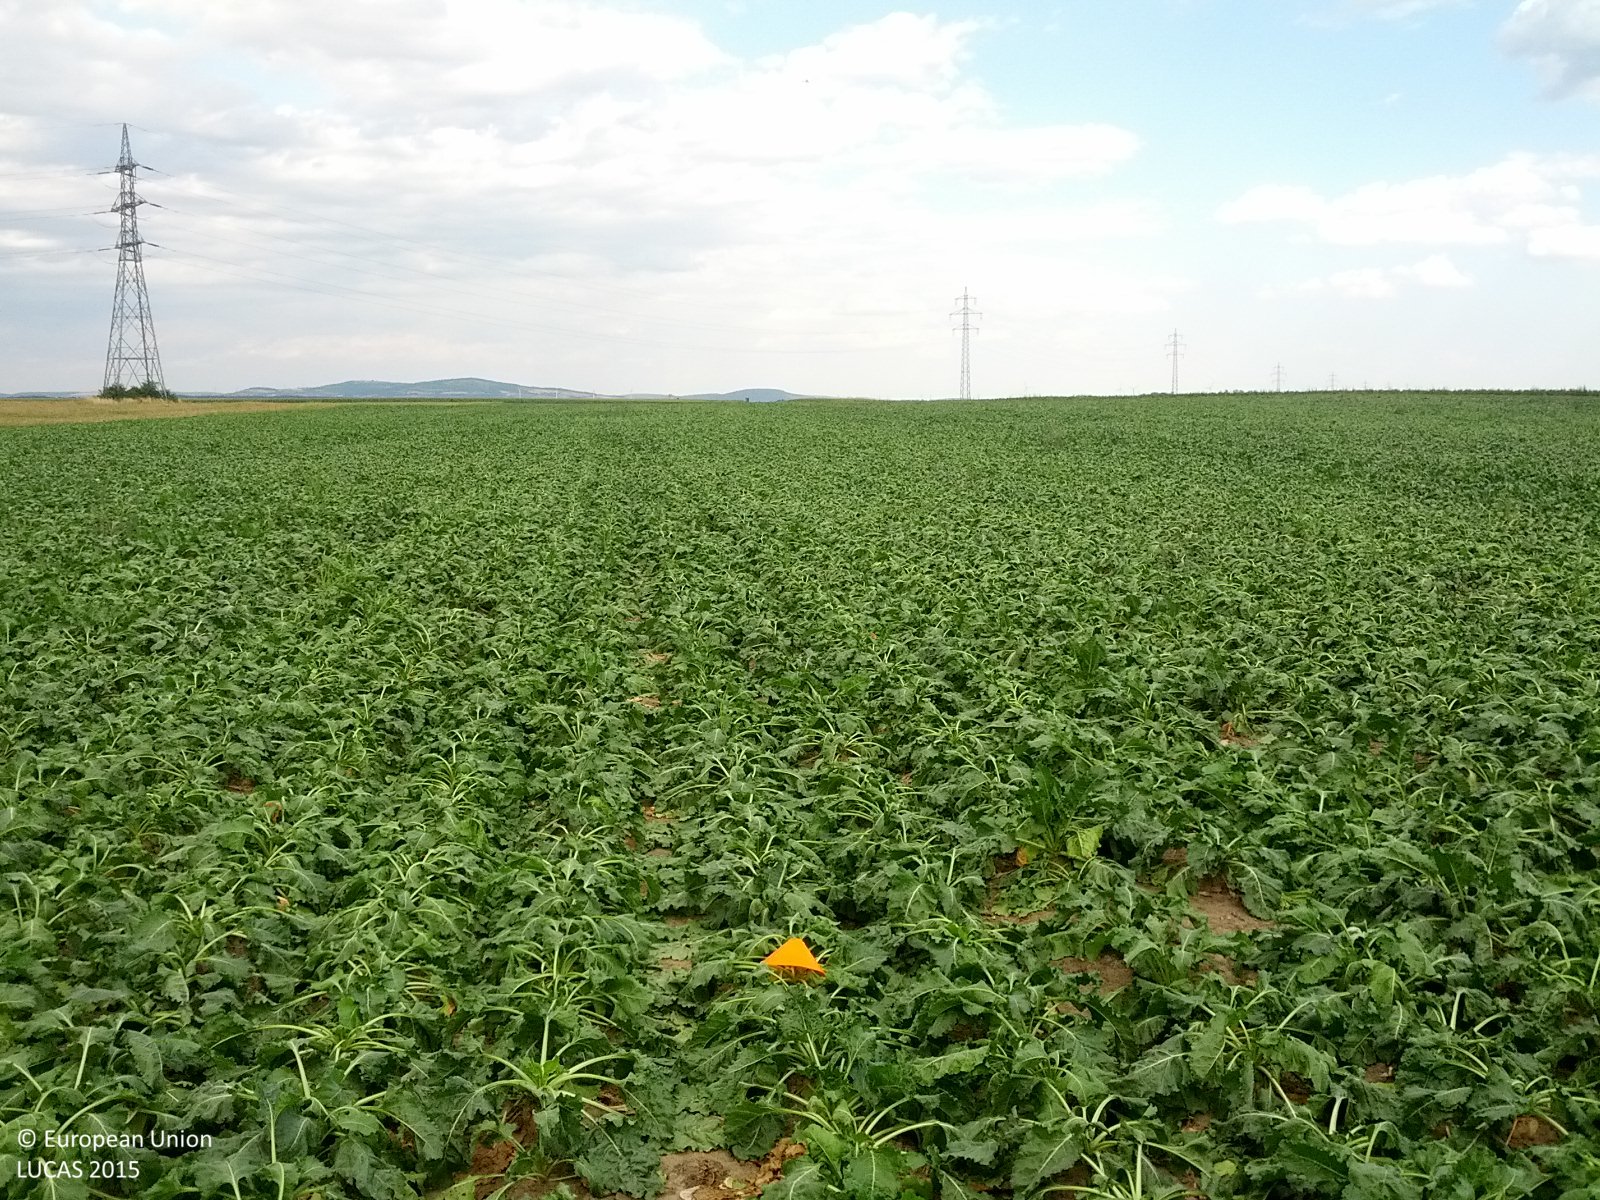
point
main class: Cropland
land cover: Sugar beet
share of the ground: > 75 %
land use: Agriculture (excluding fallow land and kitchen gardens)
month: July
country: AT
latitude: 48.4141
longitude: 16.1249
